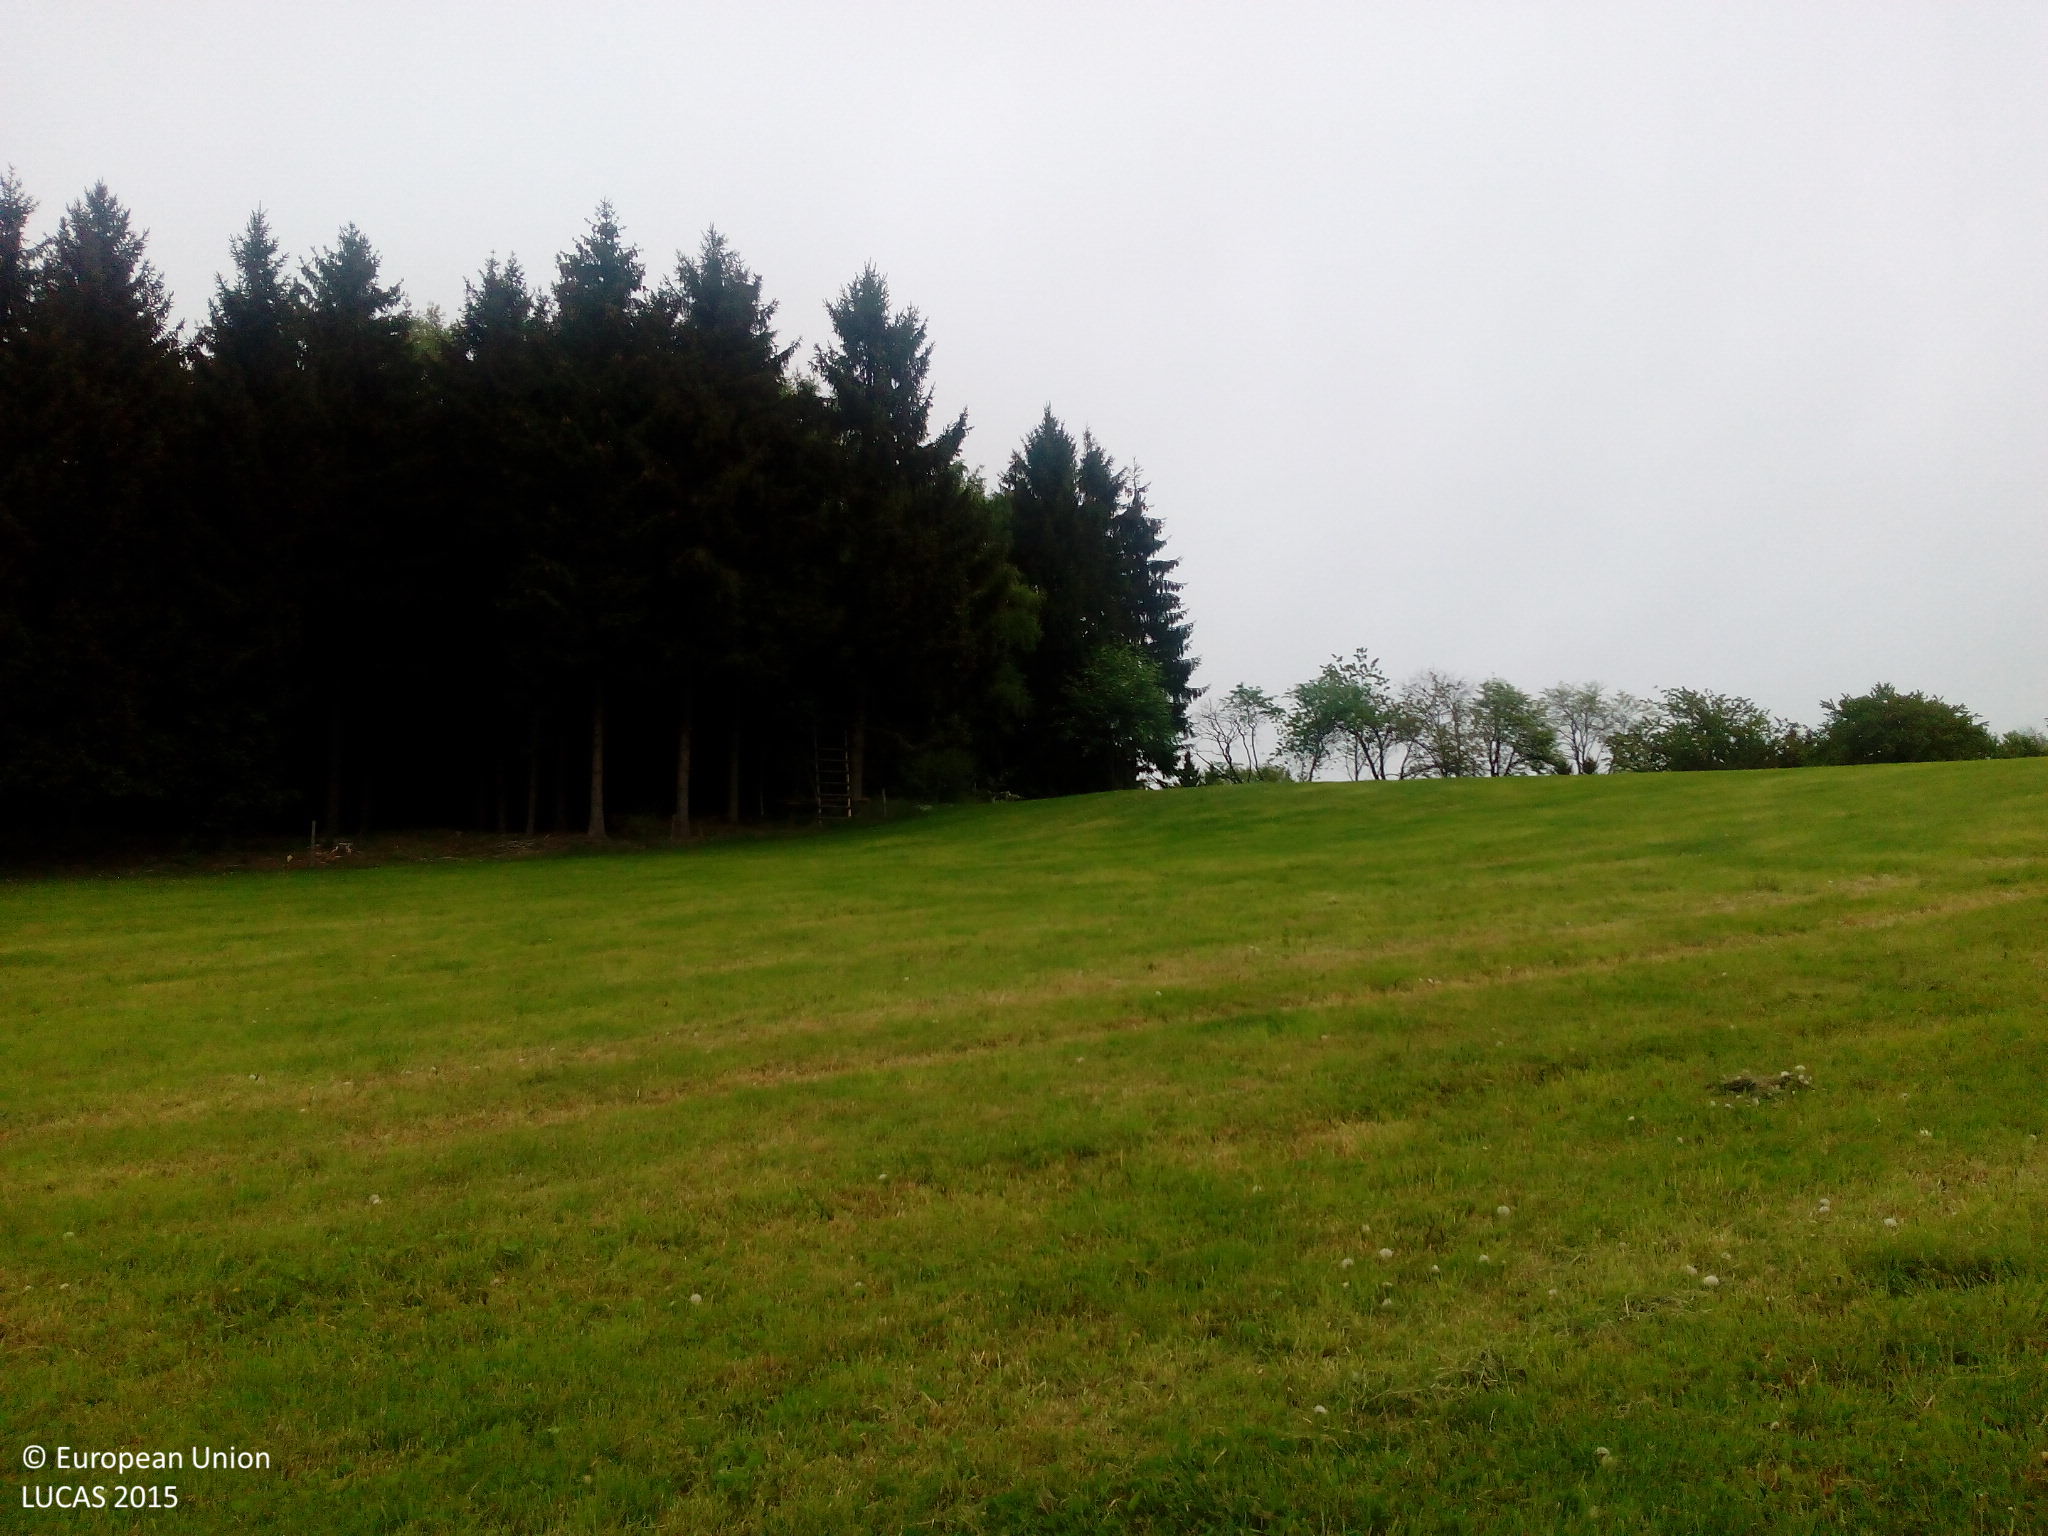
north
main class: Grassland
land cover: Grassland without tree/shrub cover
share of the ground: > 75 %
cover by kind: herbaceous plants 100 %
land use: Agriculture (excluding fallow land and kitchen gardens)
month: May
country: DE
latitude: 50.7186
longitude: 13.0737
